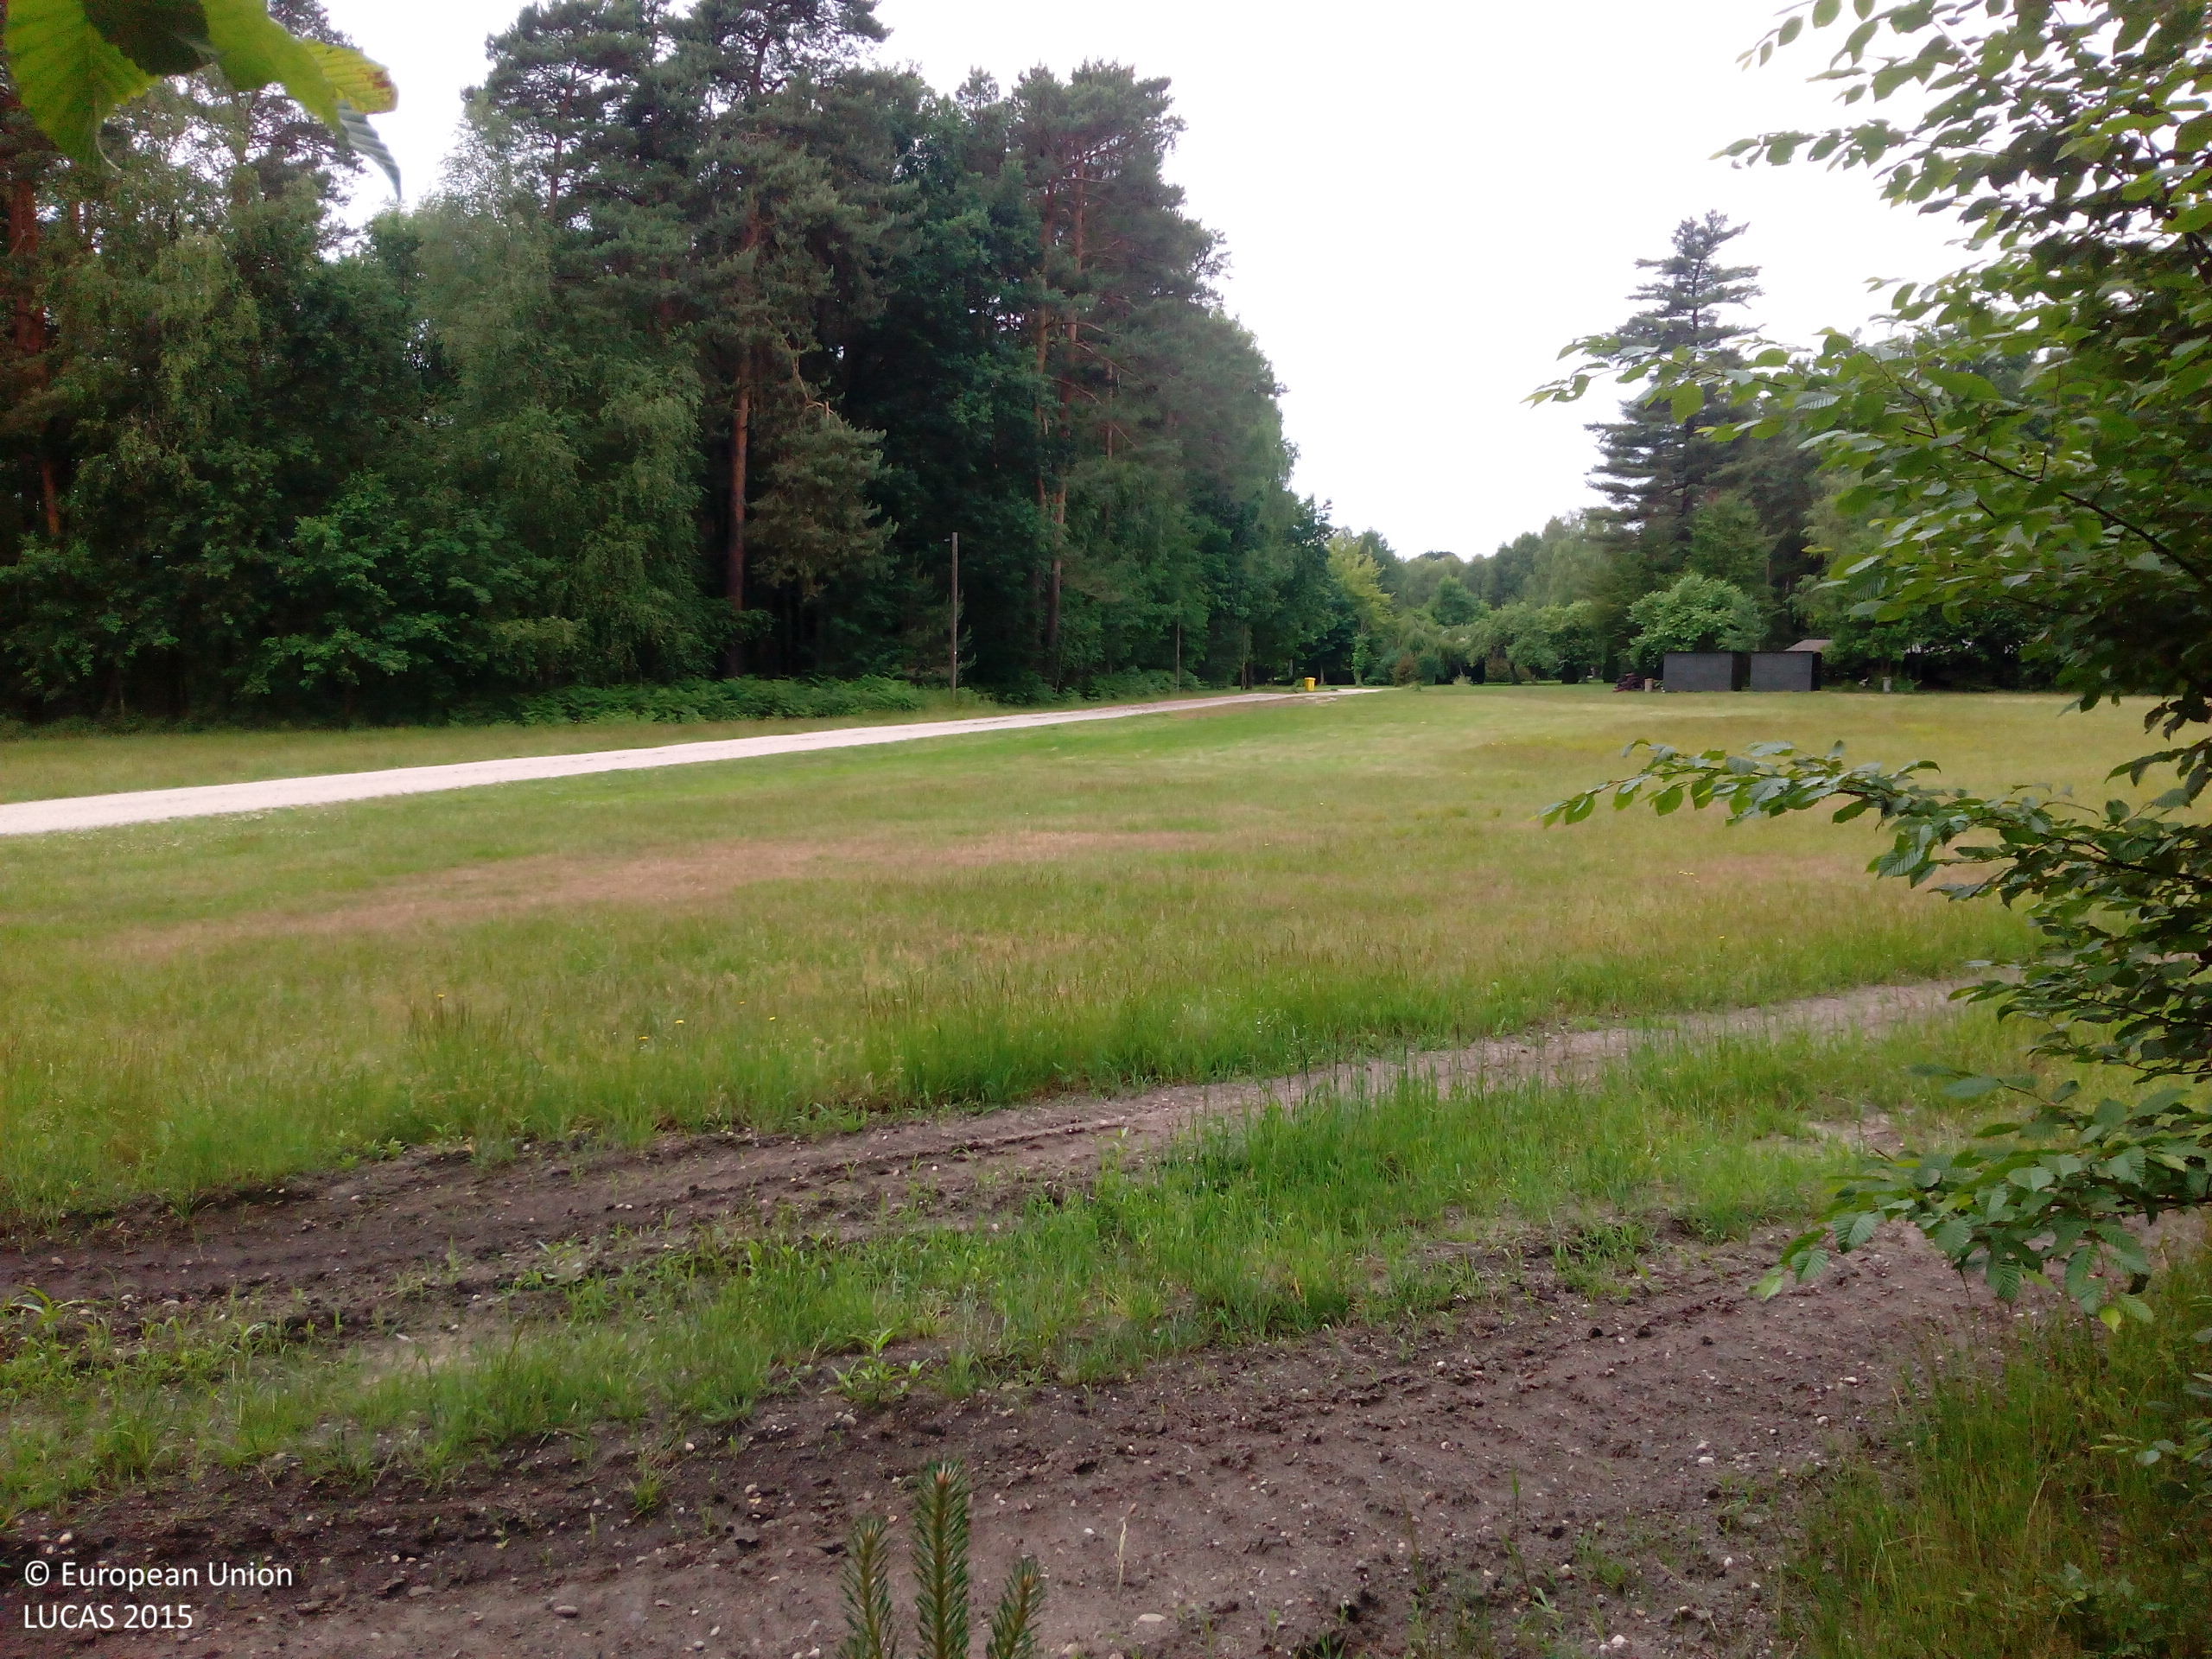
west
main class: Woodland
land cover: Pine dominated mixed woodland
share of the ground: > 75 %
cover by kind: coniferous forest trees 65 %, broadleaved forest trees 25 %, herbaceous plants 10 %
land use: Forestry
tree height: > 5 m
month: June
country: DE
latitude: 51.3560
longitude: 14.0075
